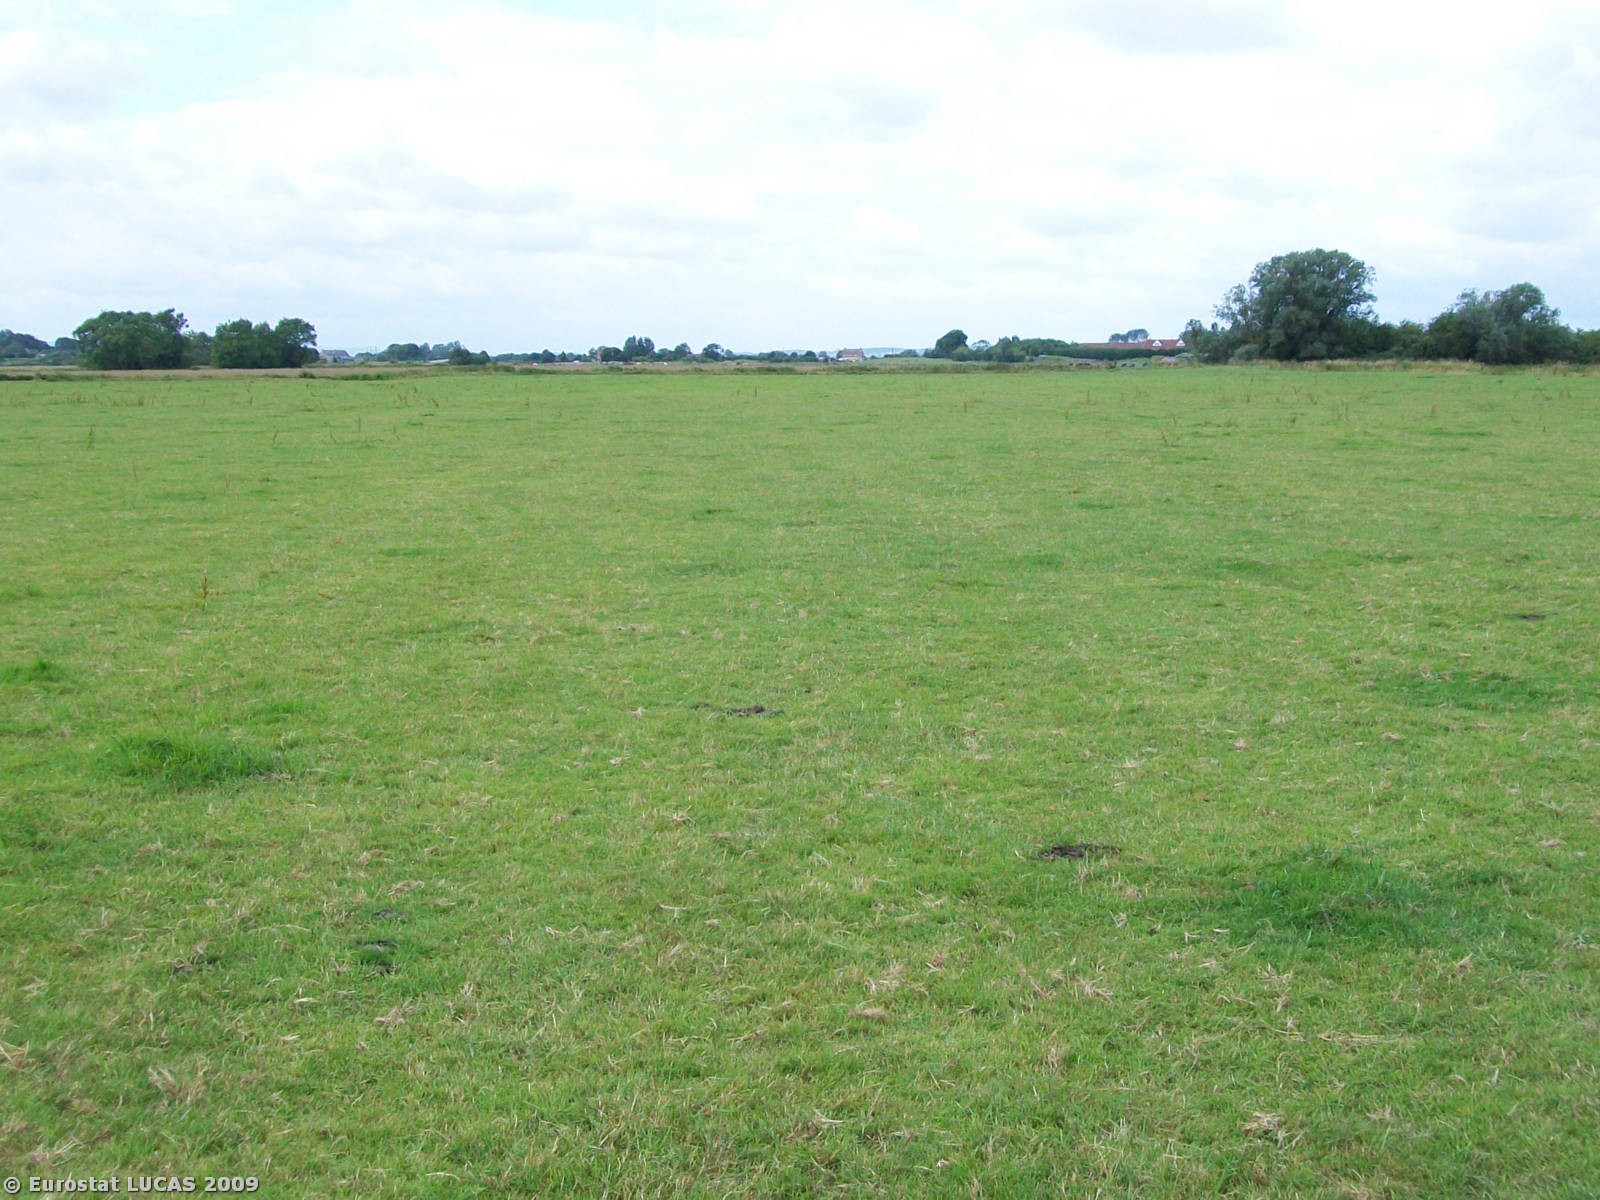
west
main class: Grassland
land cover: Grassland without tree/shrub cover
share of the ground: > 75 %
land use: Agriculture (excluding fallow land and kitchen gardens)
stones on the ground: < 10 %
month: July
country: GB
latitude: 51.0135
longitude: -2.7420
